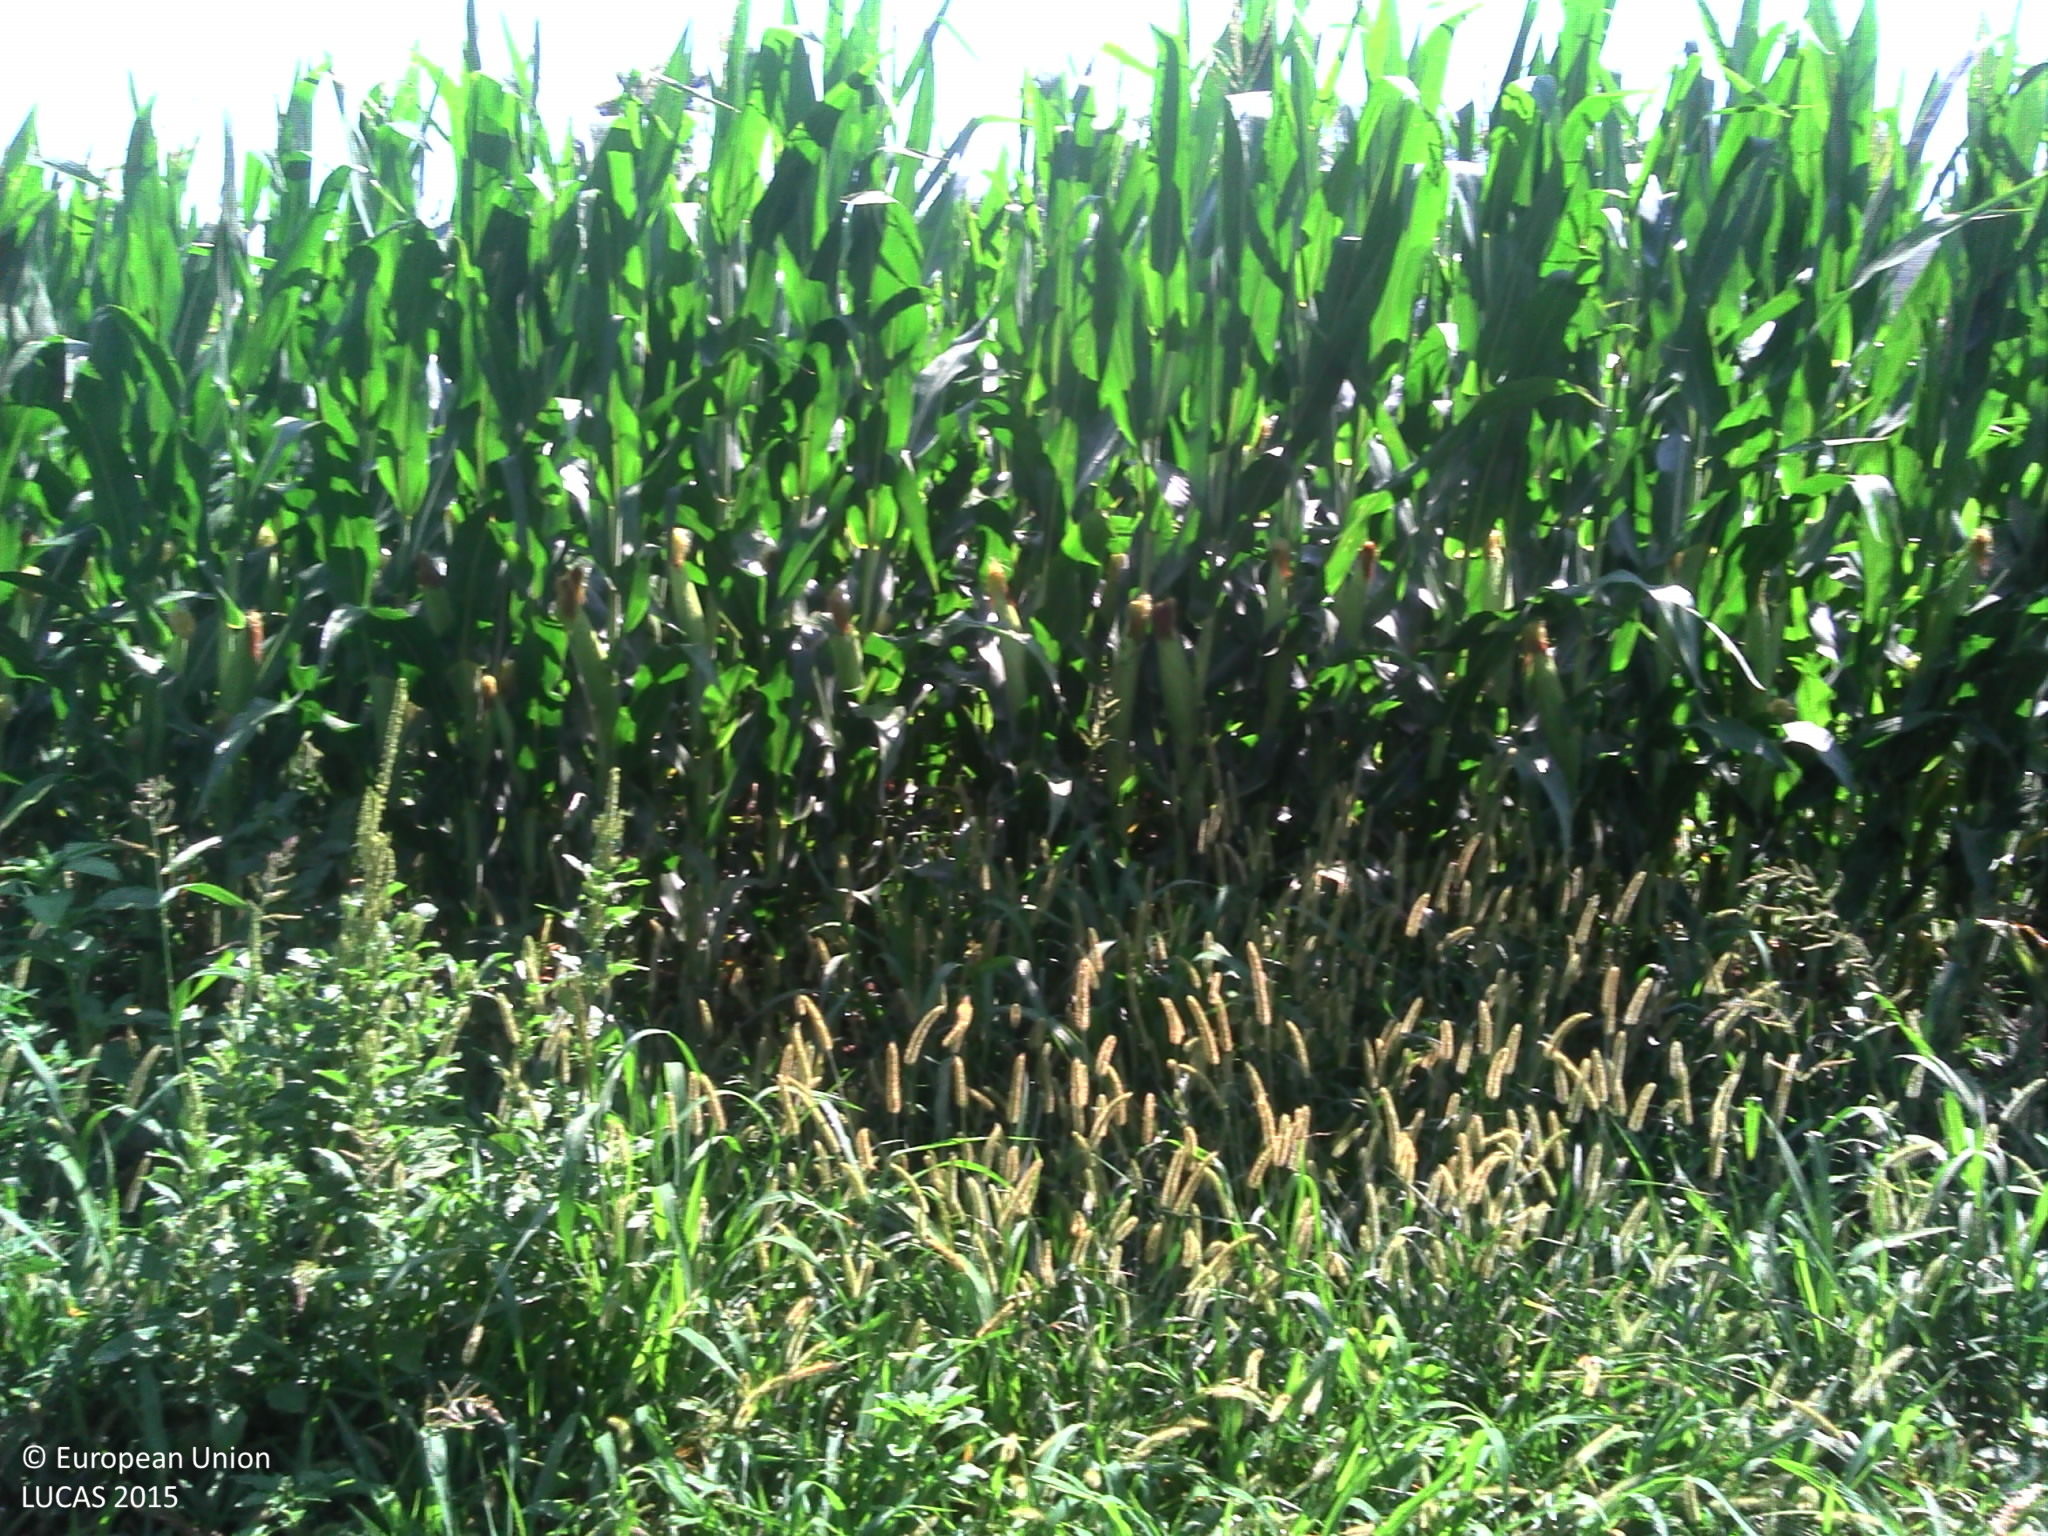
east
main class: Cropland
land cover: Maize
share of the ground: > 75 %
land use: Agriculture (excluding fallow land and kitchen gardens)
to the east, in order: Maize; Tracks; Maize; Groves; Grass margins; Paved roads, cycling and walking lanes; Grass margins; Electric lines; Abandoned hedges; Inland fresh running water; Electric lines; Shrubland with sparse tree cover
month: July
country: FR
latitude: 45.0089
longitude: 5.0447
